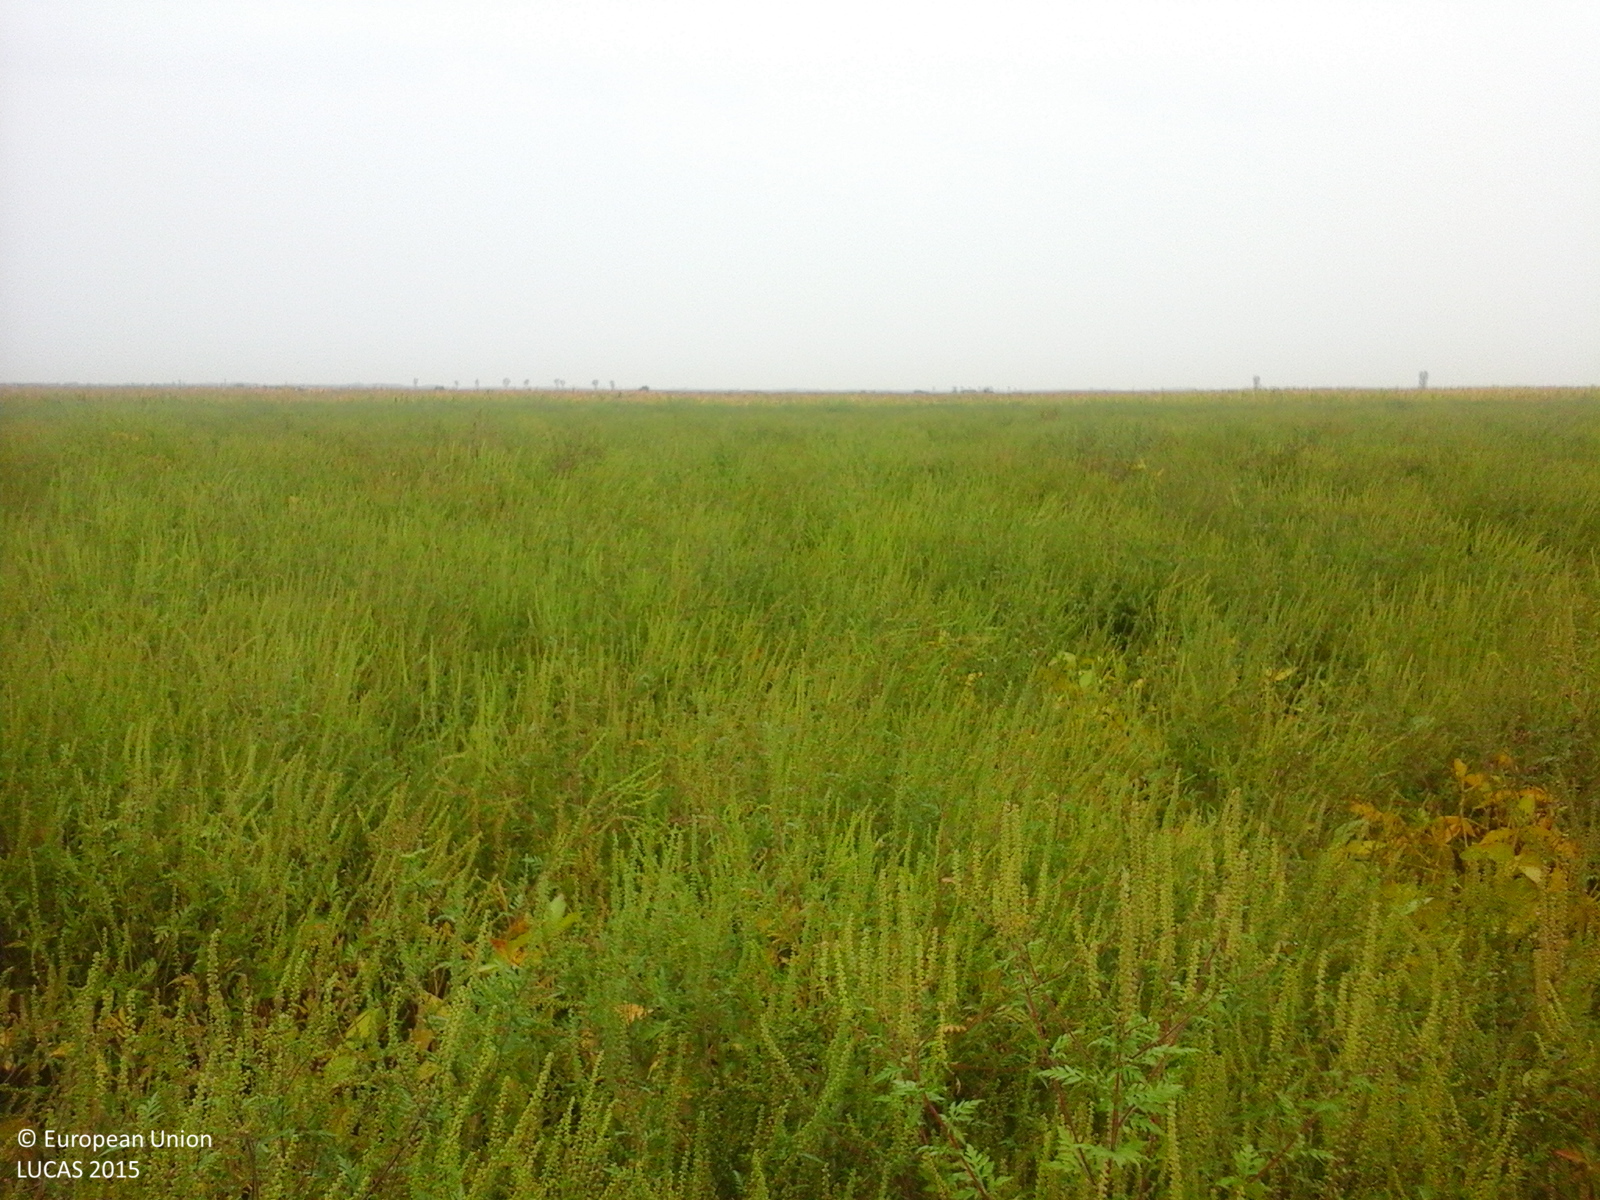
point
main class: Cropland
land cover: Soya
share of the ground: > 75 %
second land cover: Spontaneously vegetated surfaces
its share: > 75 %
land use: Agriculture (excluding fallow land and kitchen gardens)
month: September
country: RO
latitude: 47.7806
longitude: 22.5107
